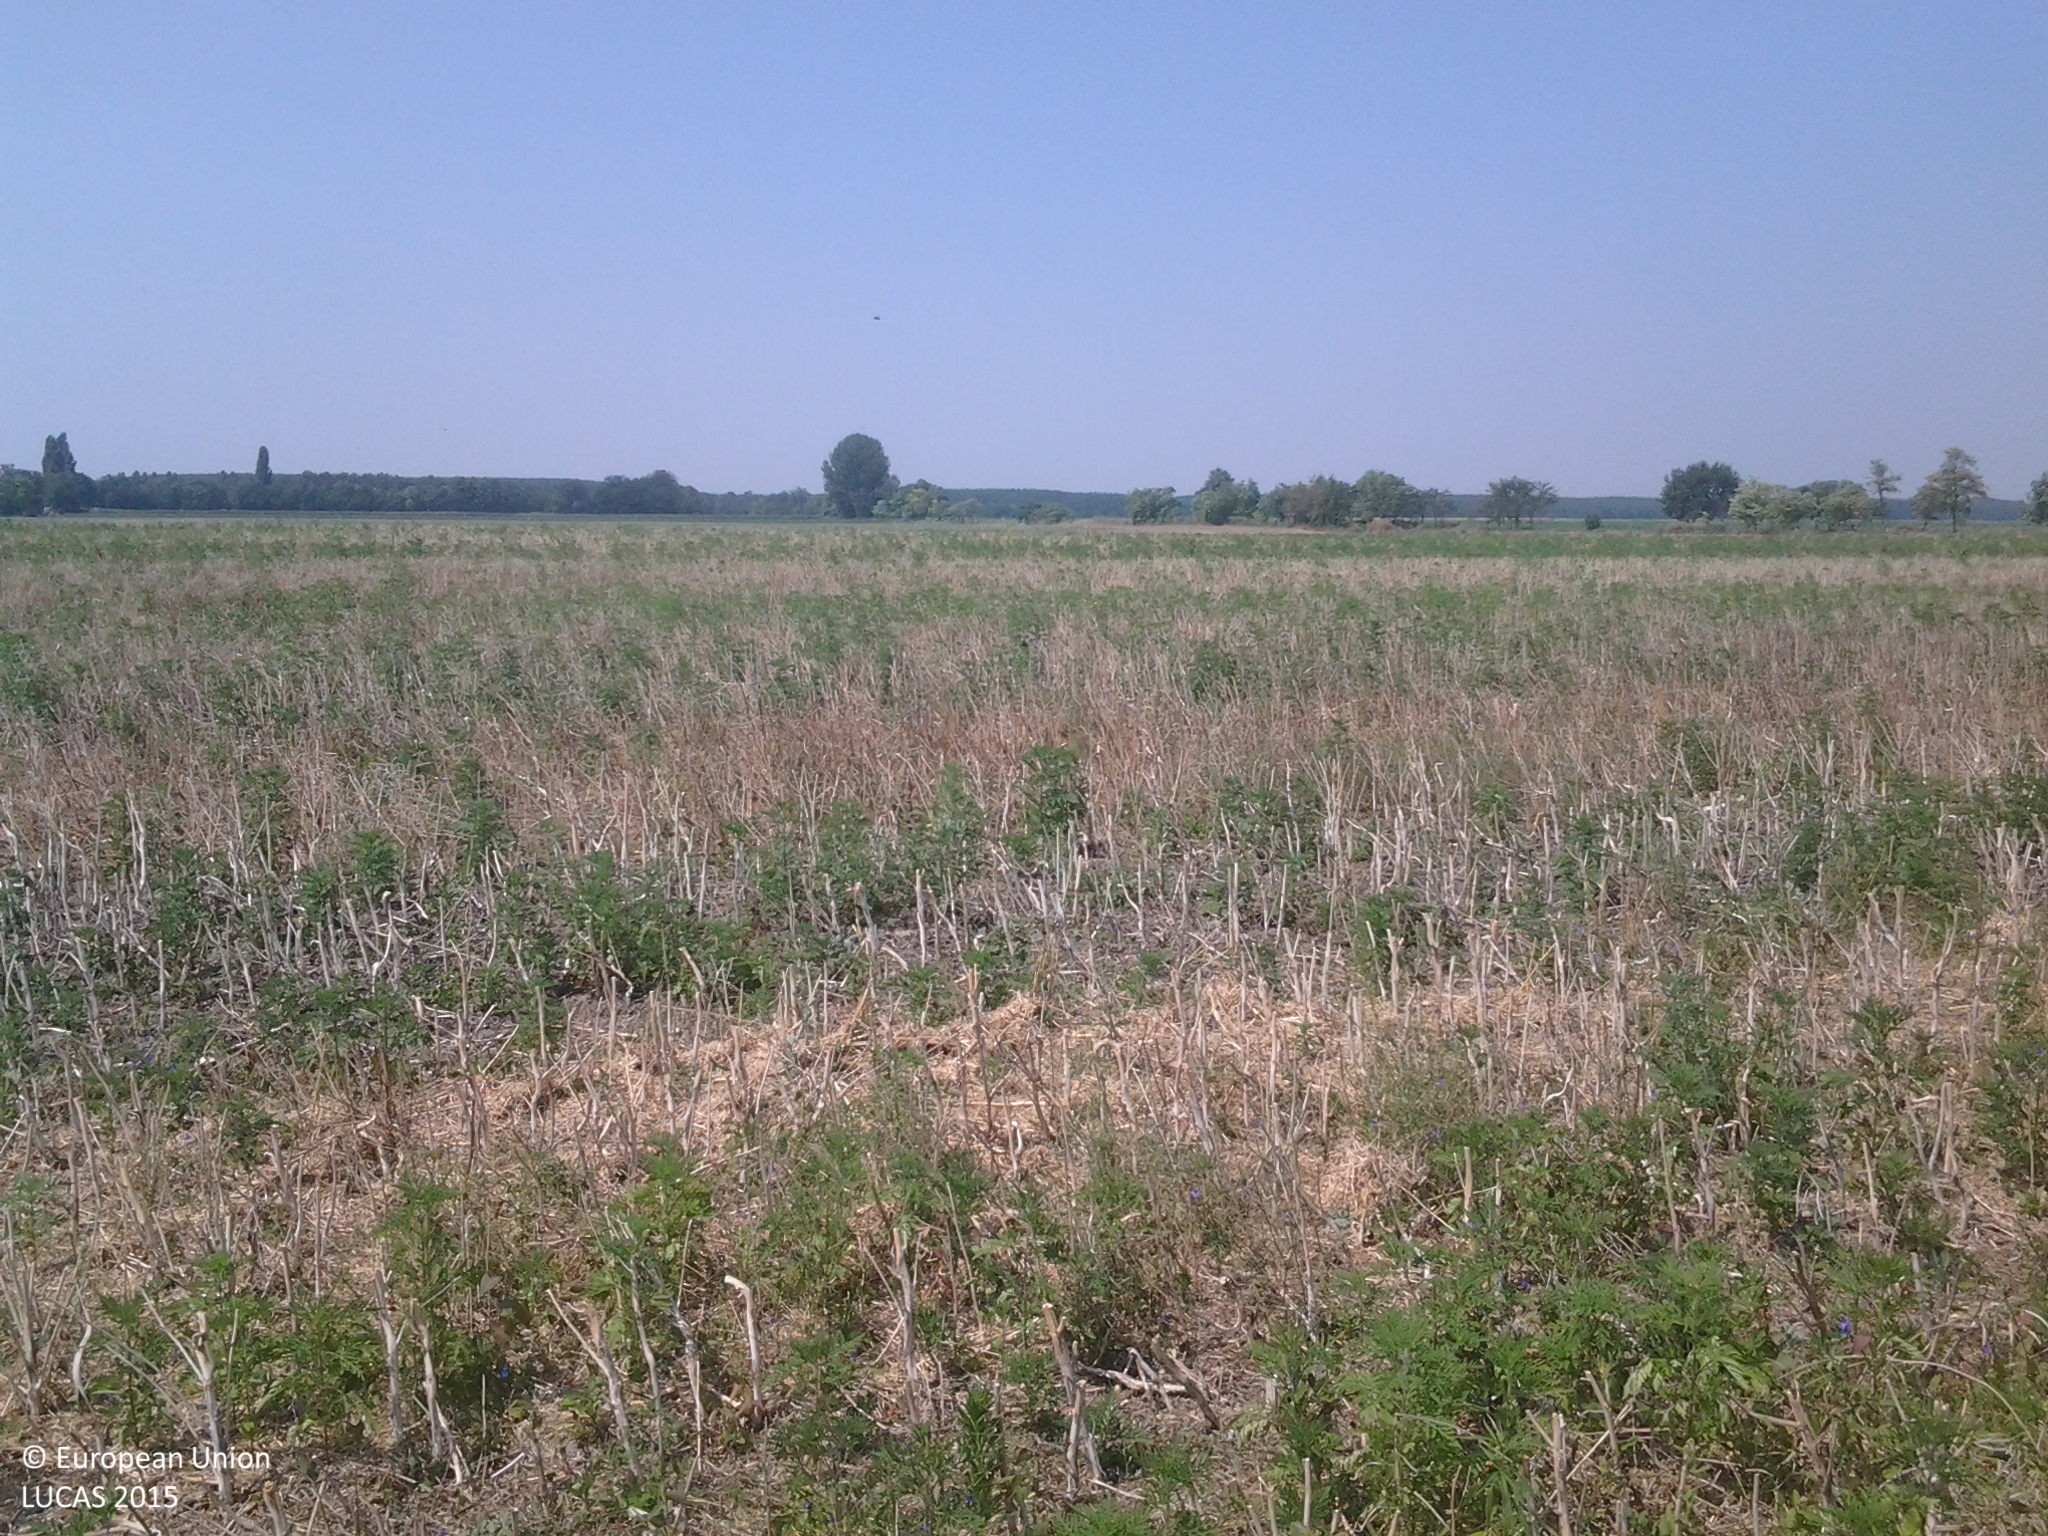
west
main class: Cropland
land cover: Rape and turnip rape
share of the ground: > 75 %
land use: Agriculture (excluding fallow land and kitchen gardens)
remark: Harvested field
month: July
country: HU
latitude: 46.8545
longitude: 19.0521
